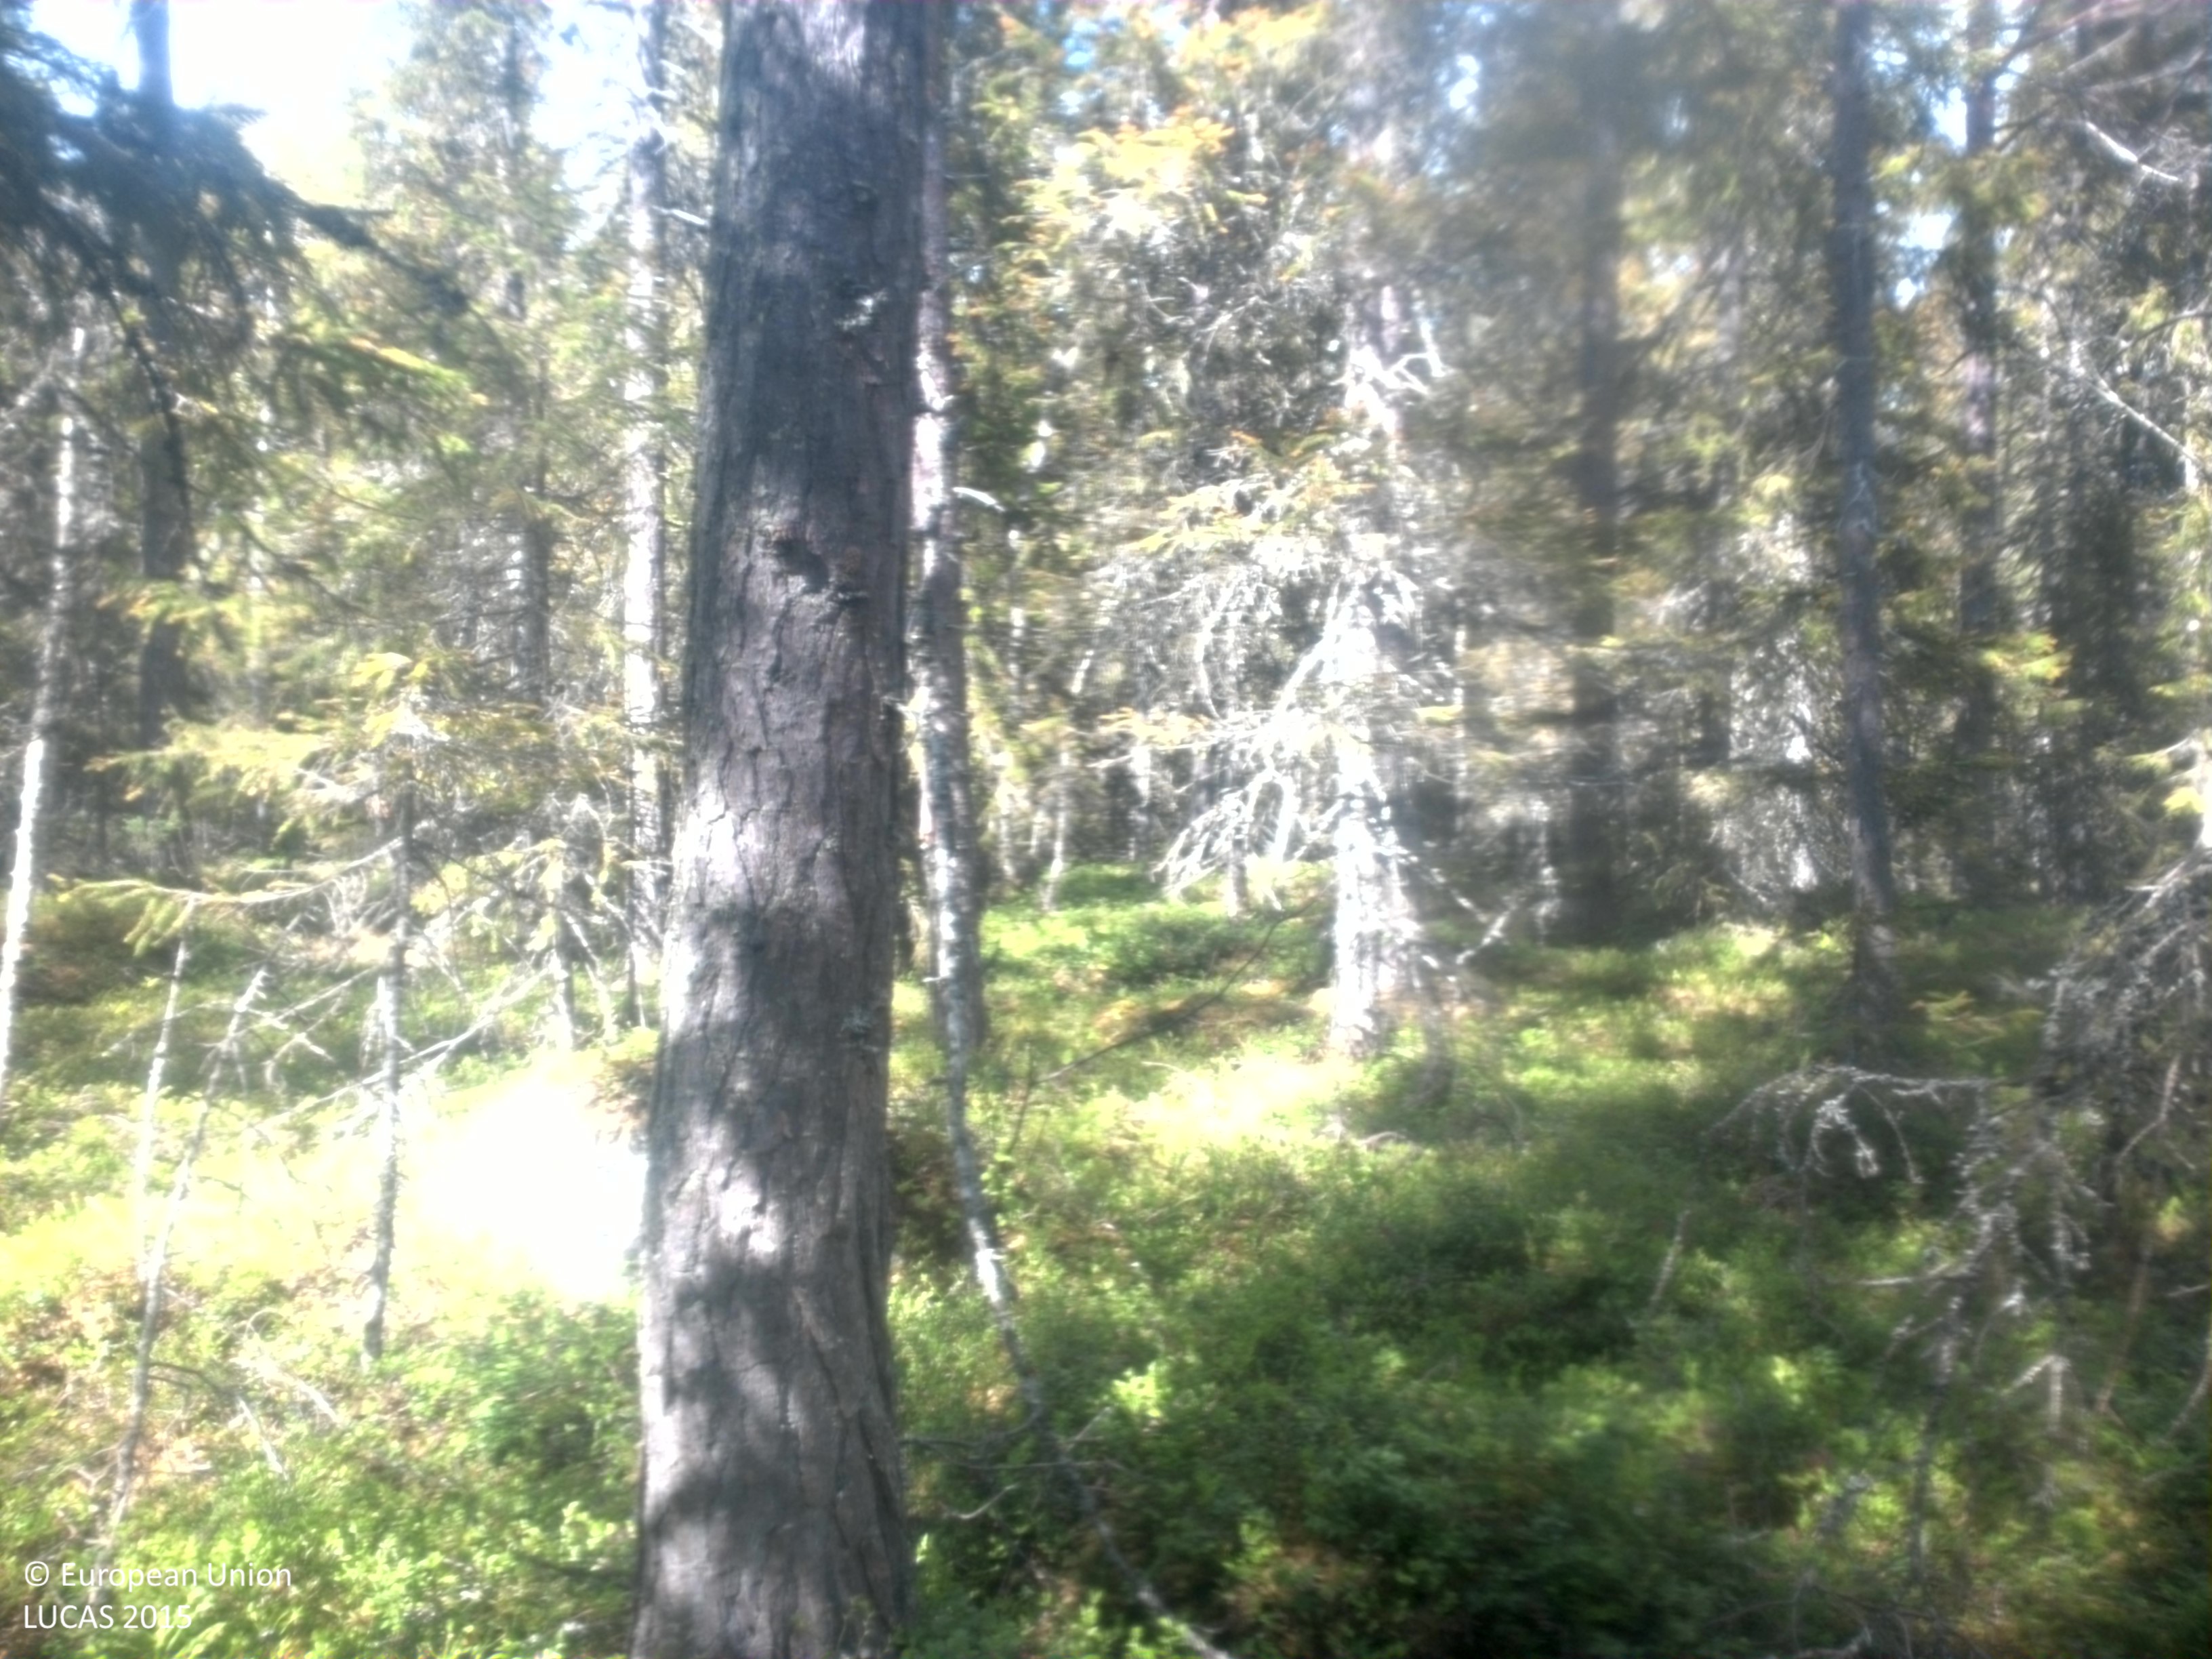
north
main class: Woodland
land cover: Pine dominated coniferous woodland
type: boreal forest
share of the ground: 50 - 75 %
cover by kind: coniferous forest trees 50 %, herbaceous plants 25 %, lichens and mosses 10 %, broadleaved forest trees 5 %, shrubs 5 %, unconsolidated bare surface 5 %
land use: Forestry
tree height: > 5 m
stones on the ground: 25 - 50 %
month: June
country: SE
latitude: 64.3368
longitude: 17.7292
